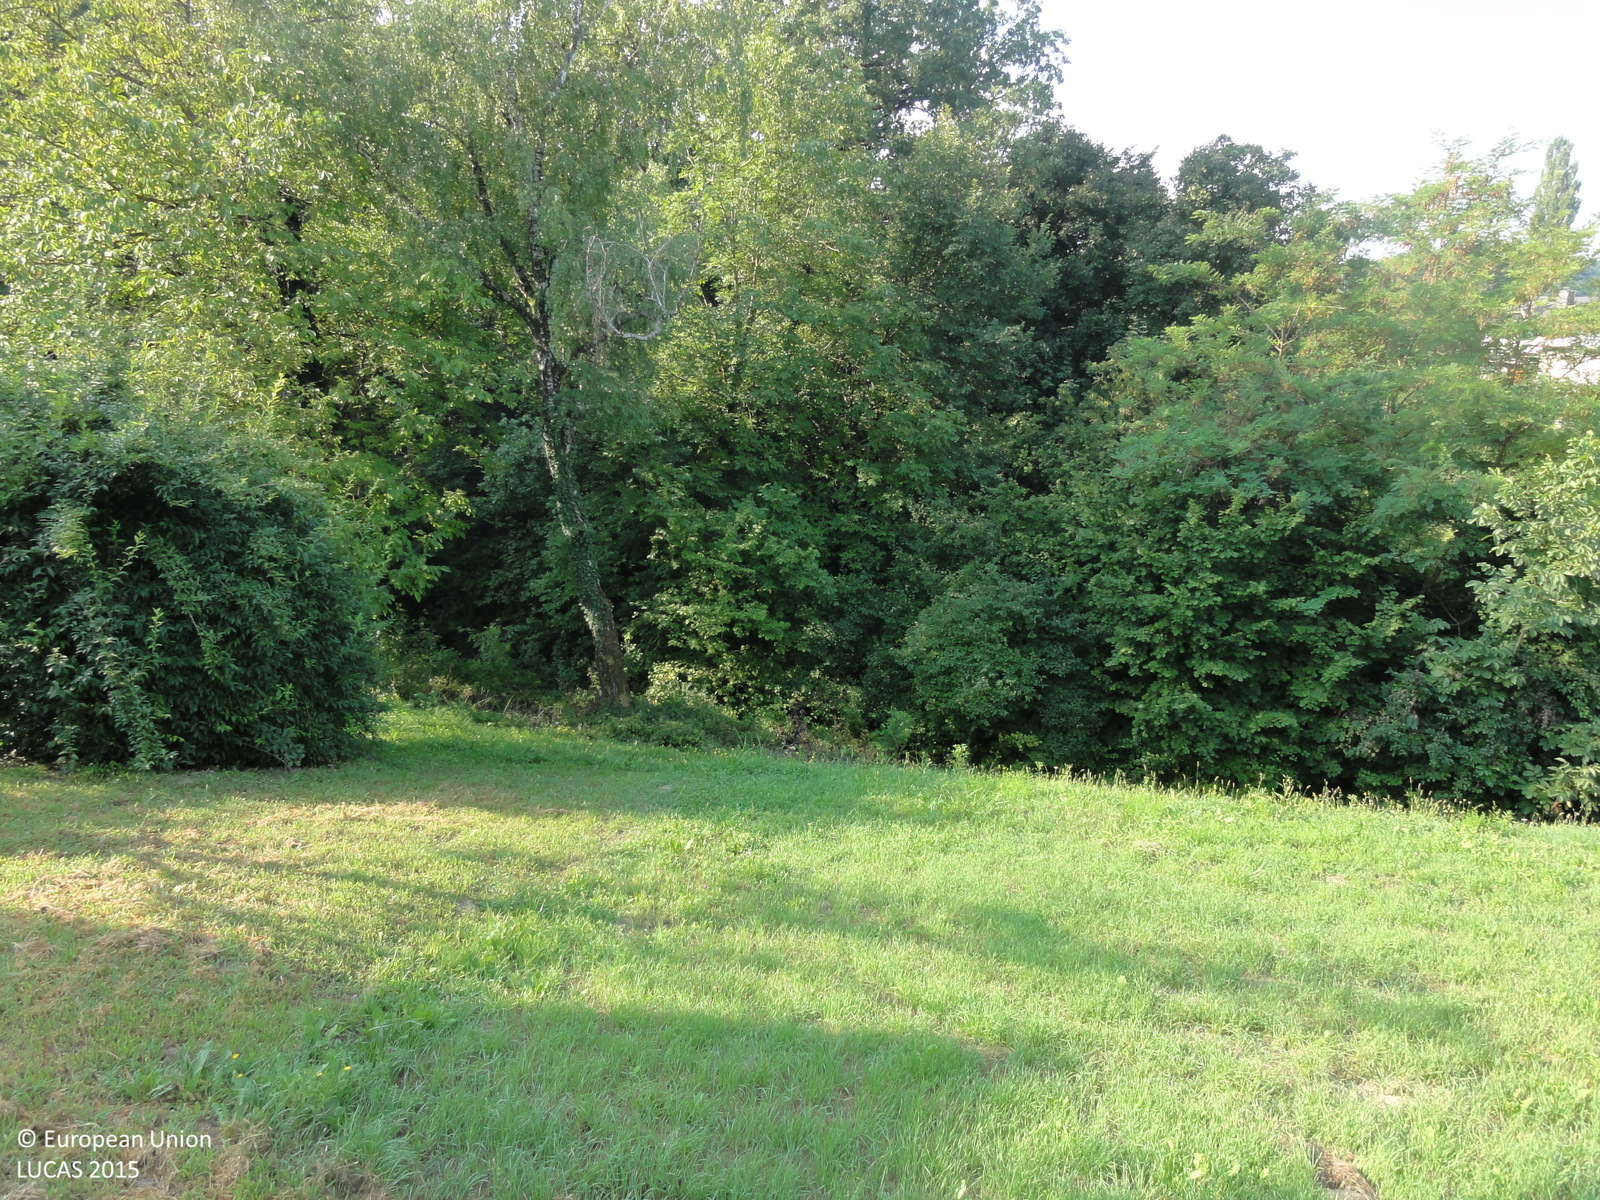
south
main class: Grassland
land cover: Grassland without tree/shrub cover
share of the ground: > 75 %
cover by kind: herbaceous plants 100 %
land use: Agriculture (excluding fallow land and kitchen gardens)
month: August
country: SI
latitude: 46.0024
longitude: 15.6666
